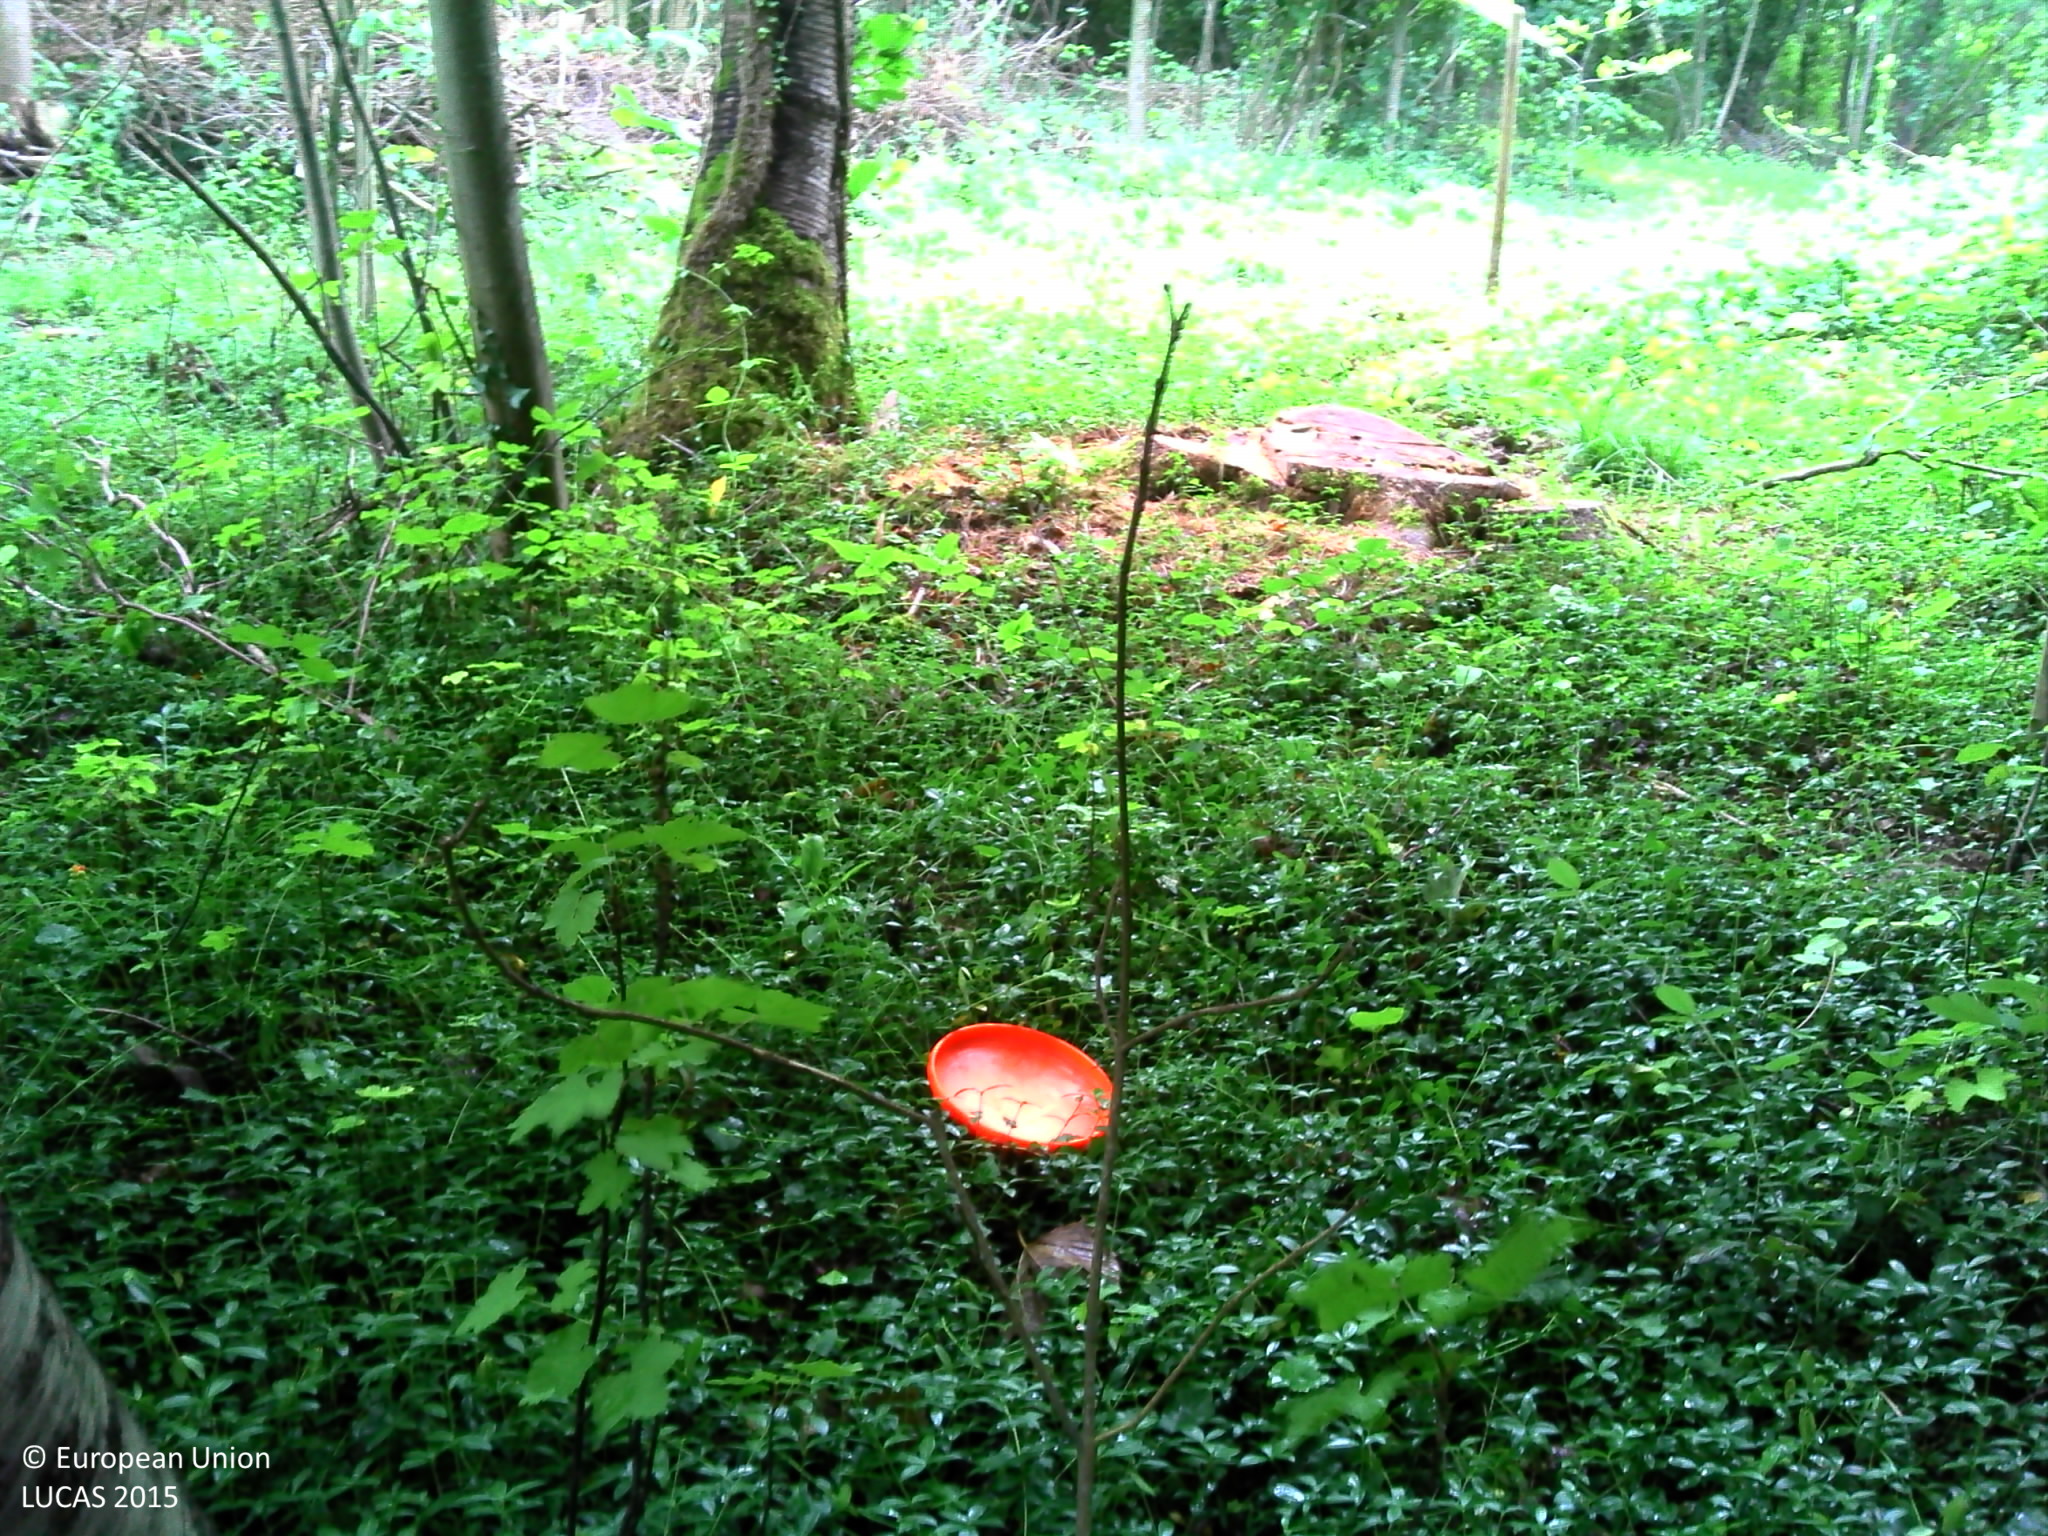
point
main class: Woodland
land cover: Broadleaved woodland
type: mesophytic deciduous forest
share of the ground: > 75 %
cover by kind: broadleaved forest trees 80 %, herbaceous plants 20 %
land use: Forestry
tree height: > 5 m
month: July
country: FR
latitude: 50.8278
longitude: 2.0483
